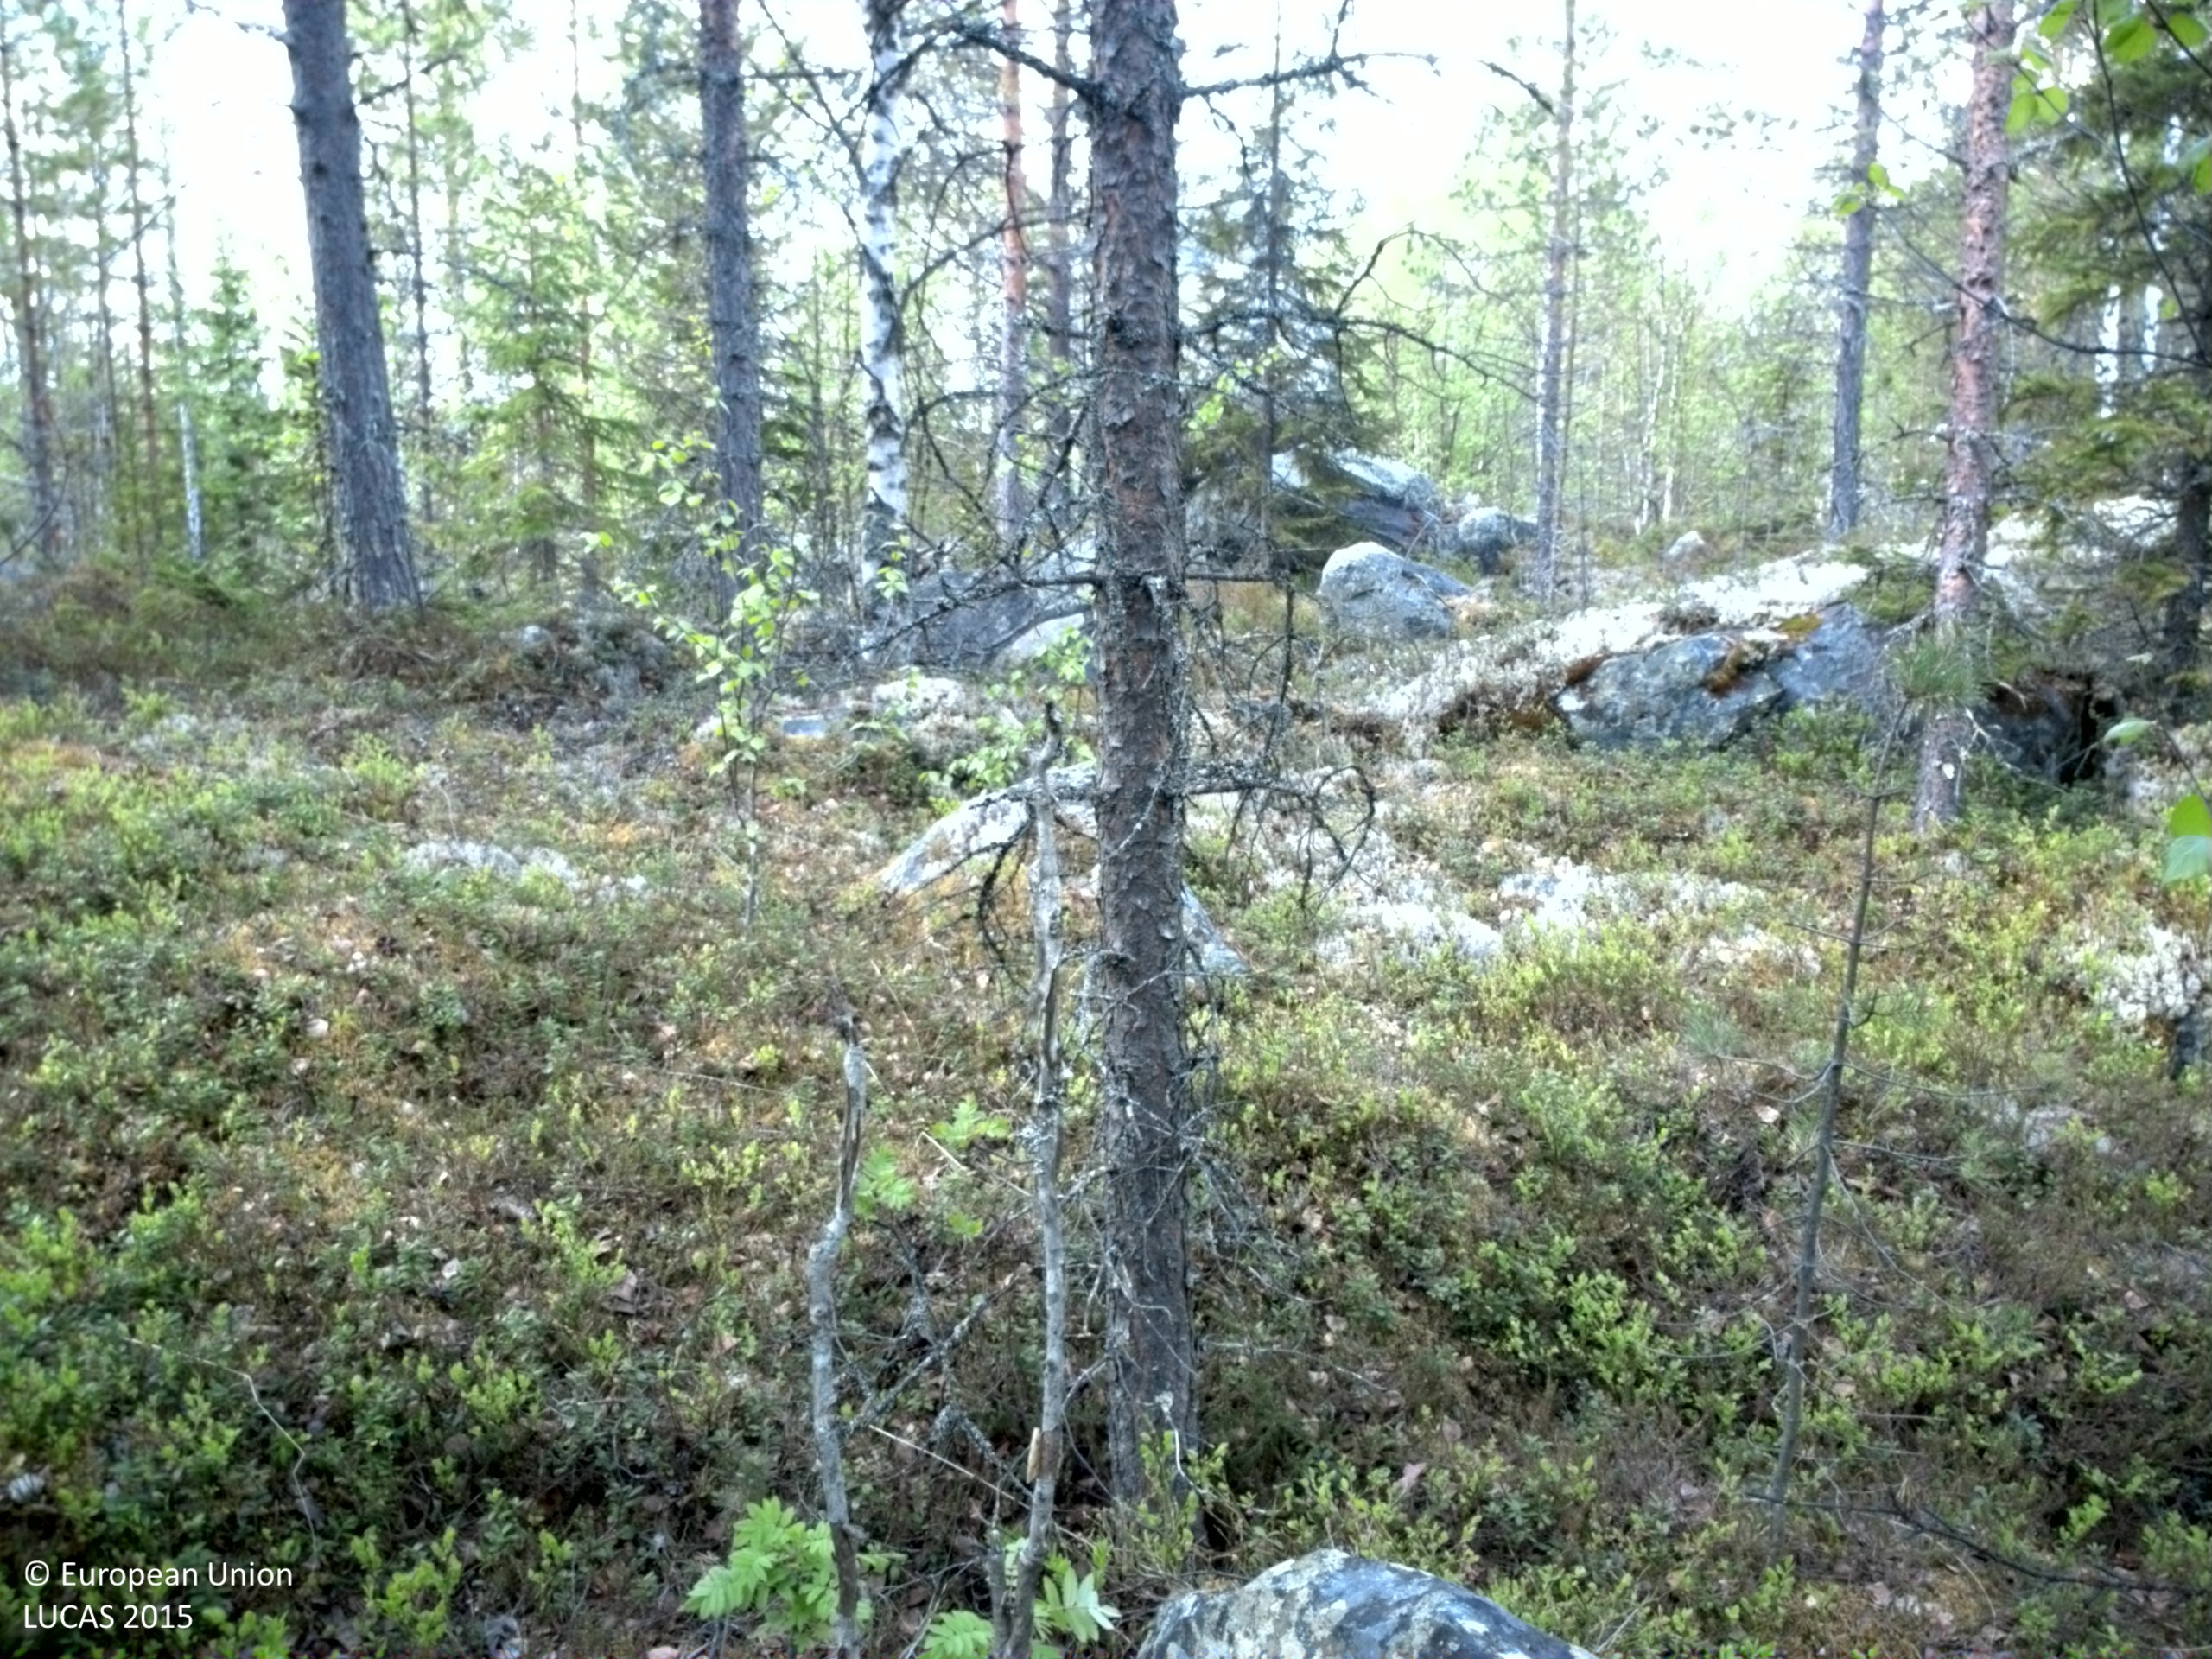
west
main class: Woodland
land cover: Pine dominated mixed woodland
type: boreal forest
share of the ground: 50 - 75 %
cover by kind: coniferous forest trees 50 %, shrubs 30 %, broadleaved forest trees 20 %
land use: Forestry
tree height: > 5 m
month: June
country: SE
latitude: 63.0204
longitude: 17.1881
